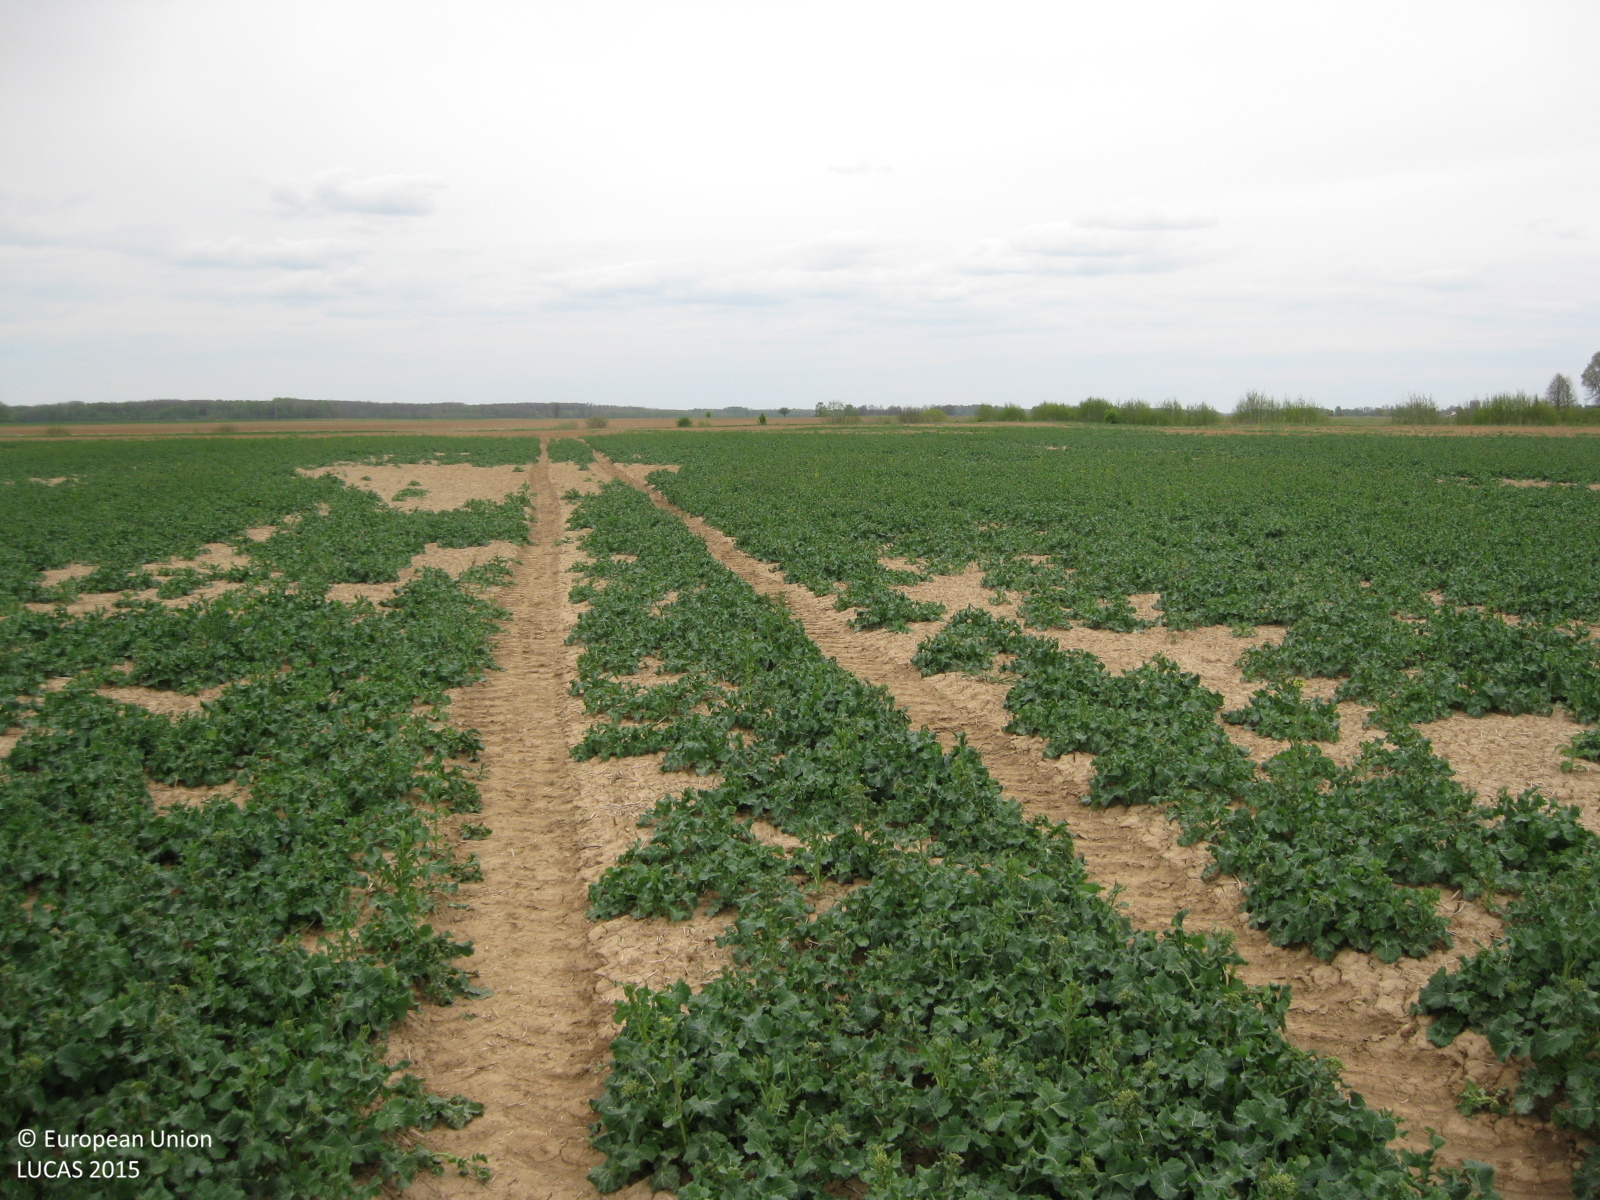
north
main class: Cropland
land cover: Rape and turnip rape
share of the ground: > 75 %
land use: Agriculture (excluding fallow land and kitchen gardens)
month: May
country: LT
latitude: 56.2010
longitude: 24.4910
